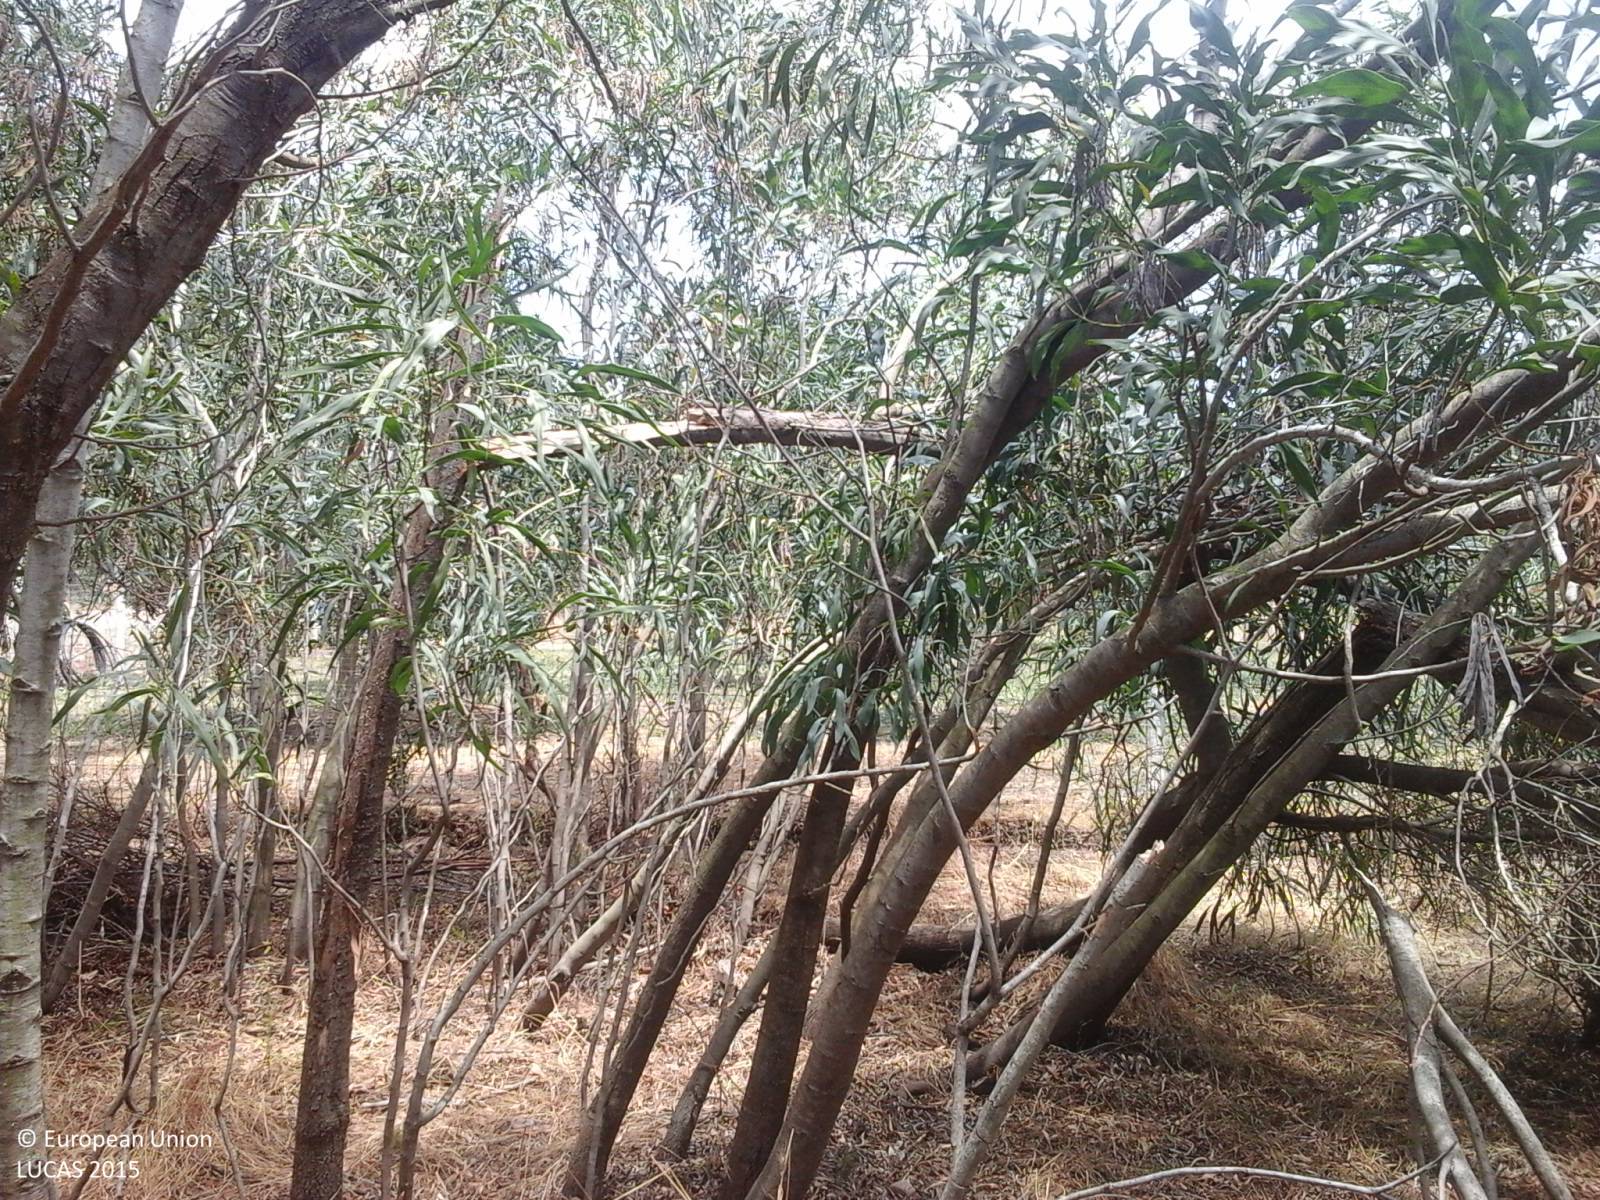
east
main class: Woodland
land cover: Broadleaved woodland
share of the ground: 50 - 75 %
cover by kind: broadleaved forest trees 65 %, unconsolidated bare surface 20 %, shrubs 10 %, herbaceous plants 5 %
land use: Abandoned areas
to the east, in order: Broadleaved woodland; Tracks; Fences; Olive groves; Fences; Tracks; Fences; Managed hedges; Artificial constructions in urban areas; Shrubland with sparse tree cover; Tracks; Shrubland without tree cover; Sand
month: June
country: IT
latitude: 39.3609
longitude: 9.5963
